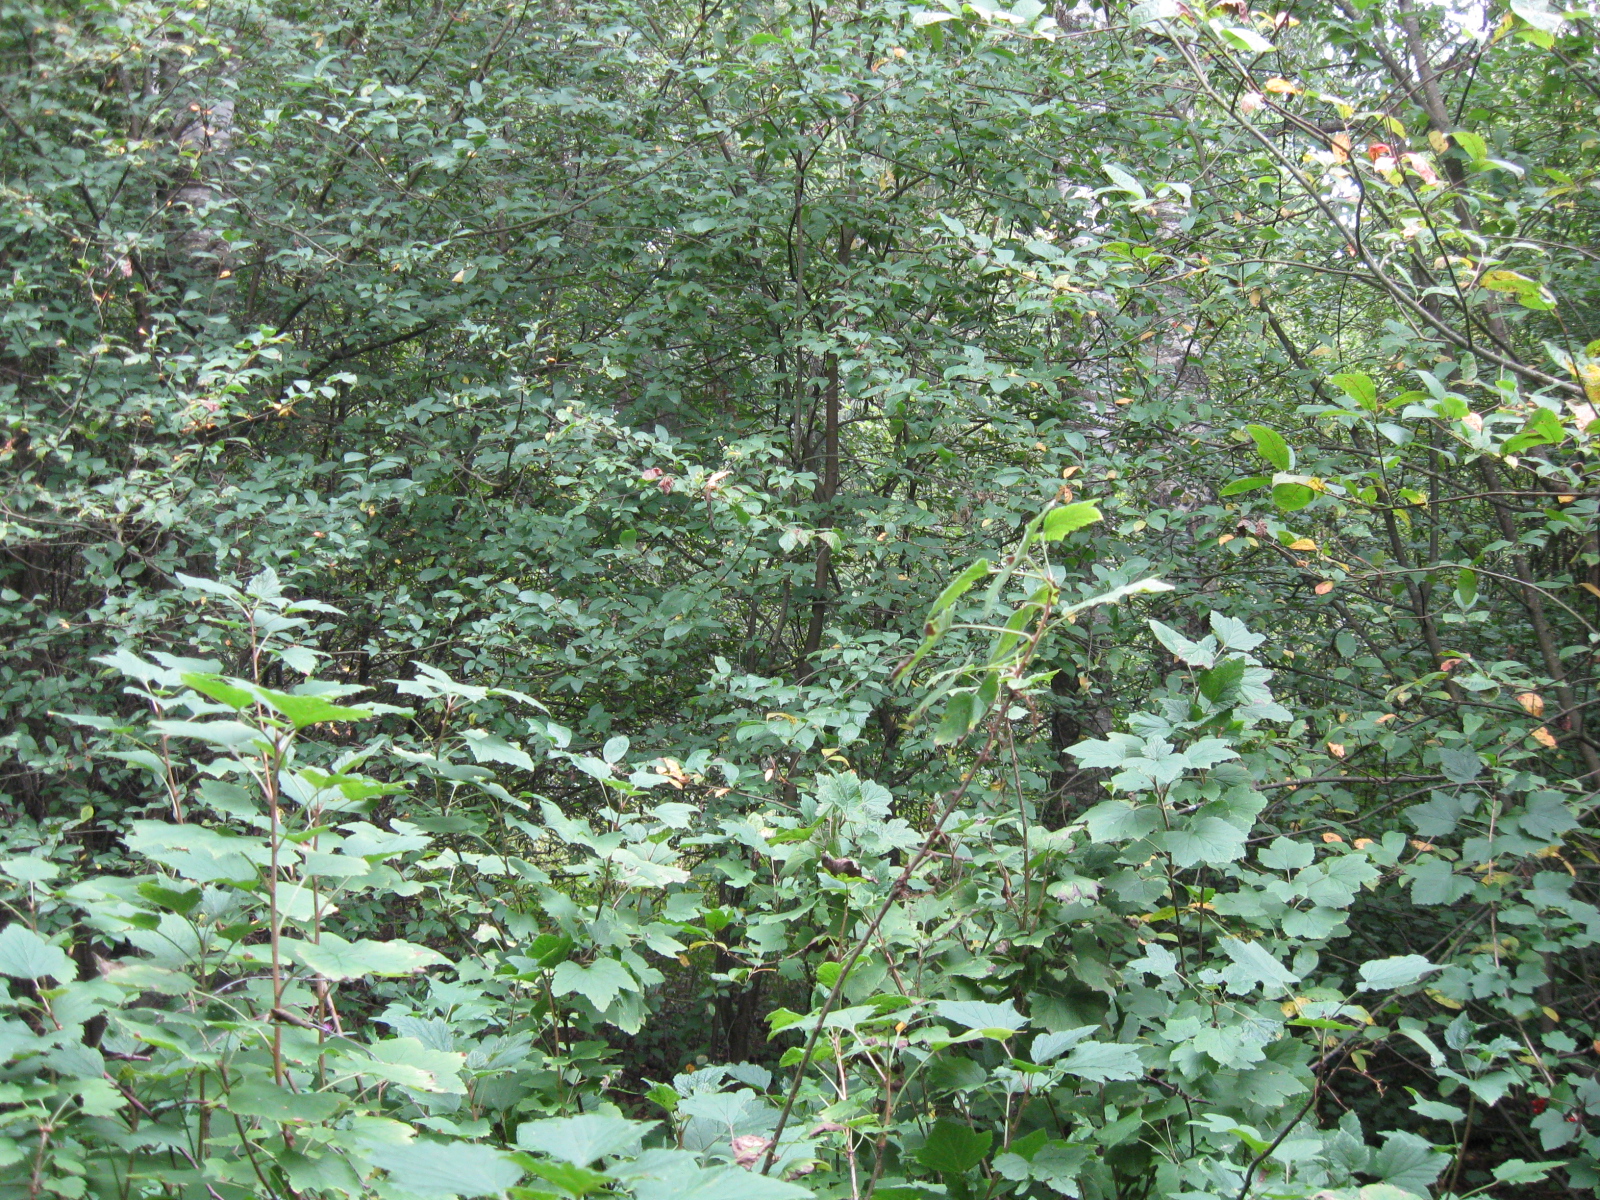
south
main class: Woodland
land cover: Broadleaved woodland
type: non-riverine alder, birch or aspen forest
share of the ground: > 75 %
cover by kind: broadleaved forest trees 85 %, herbaceous plants 10 %, coniferous forest trees 5 %
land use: Forestry
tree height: > 5 m
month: July
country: LT
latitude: 54.8611
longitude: 23.5581
